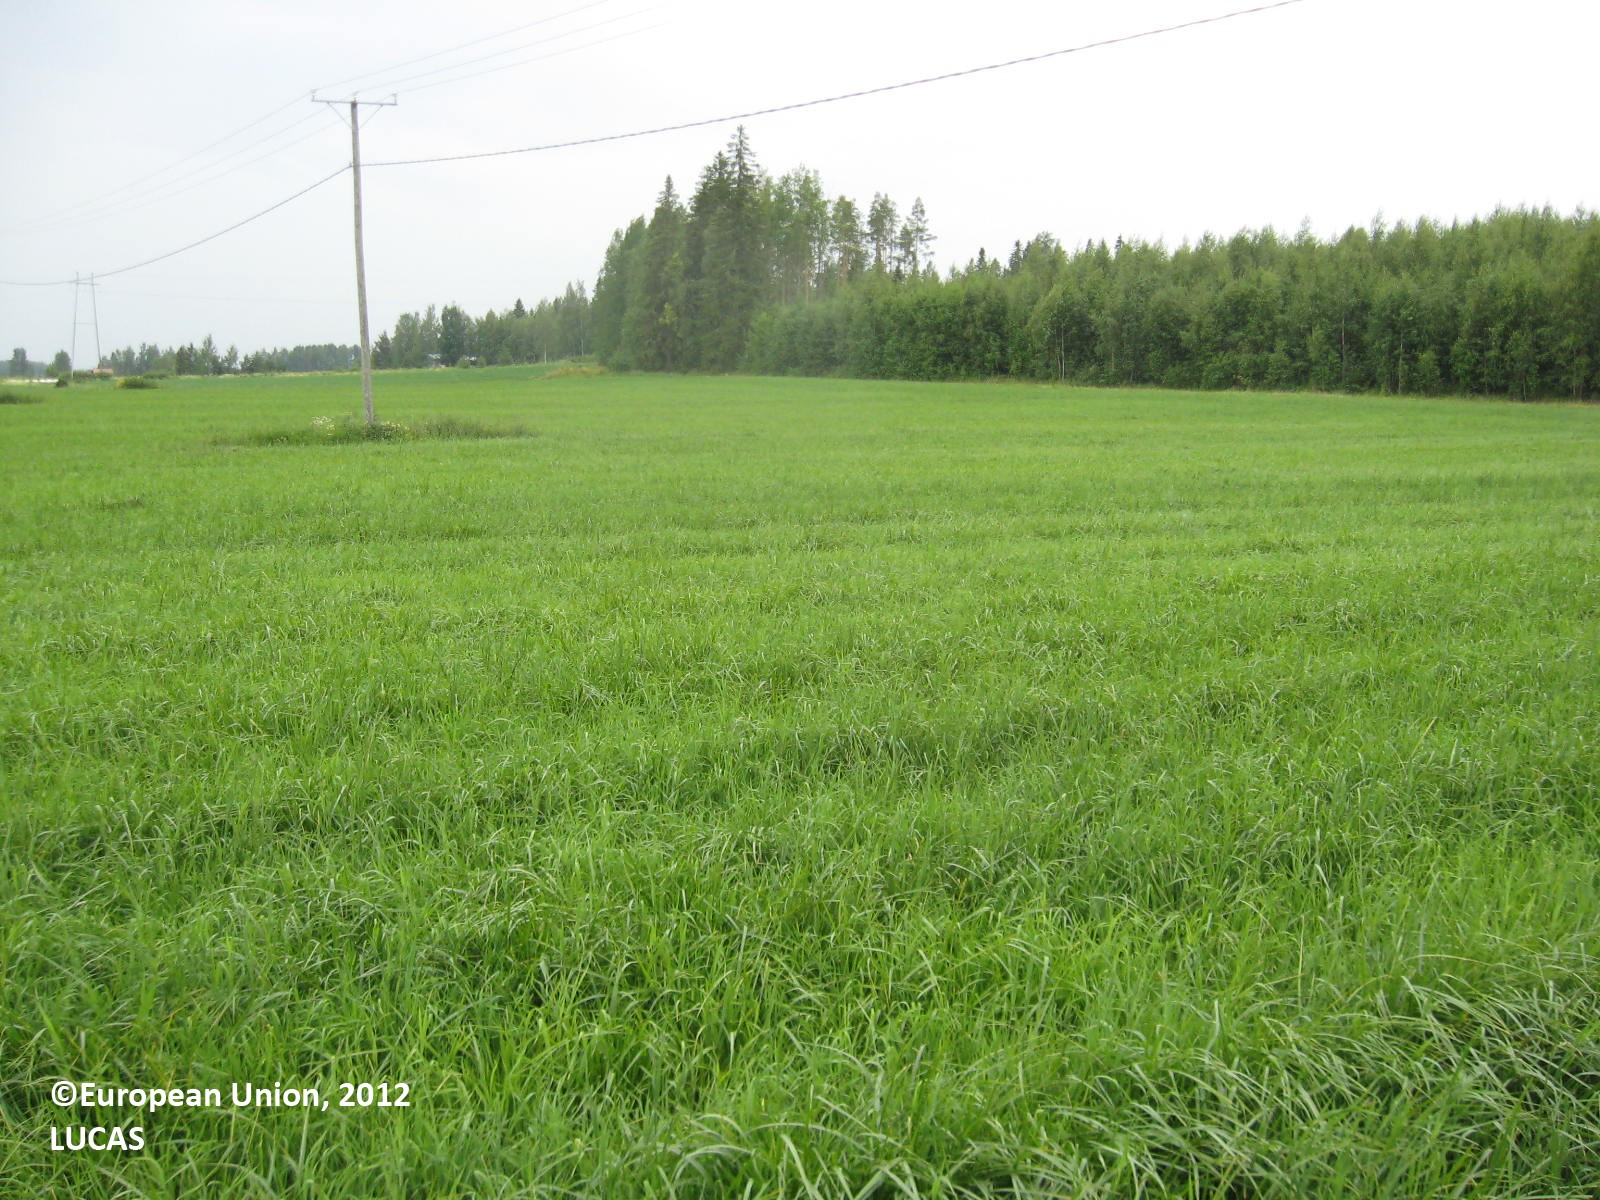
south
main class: Cropland
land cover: Temporary grasslands
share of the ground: > 75 %
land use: Agriculture (excluding fallow land and kitchen gardens)
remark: Harvested field
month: July
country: FI
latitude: 62.4694
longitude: 22.7619
